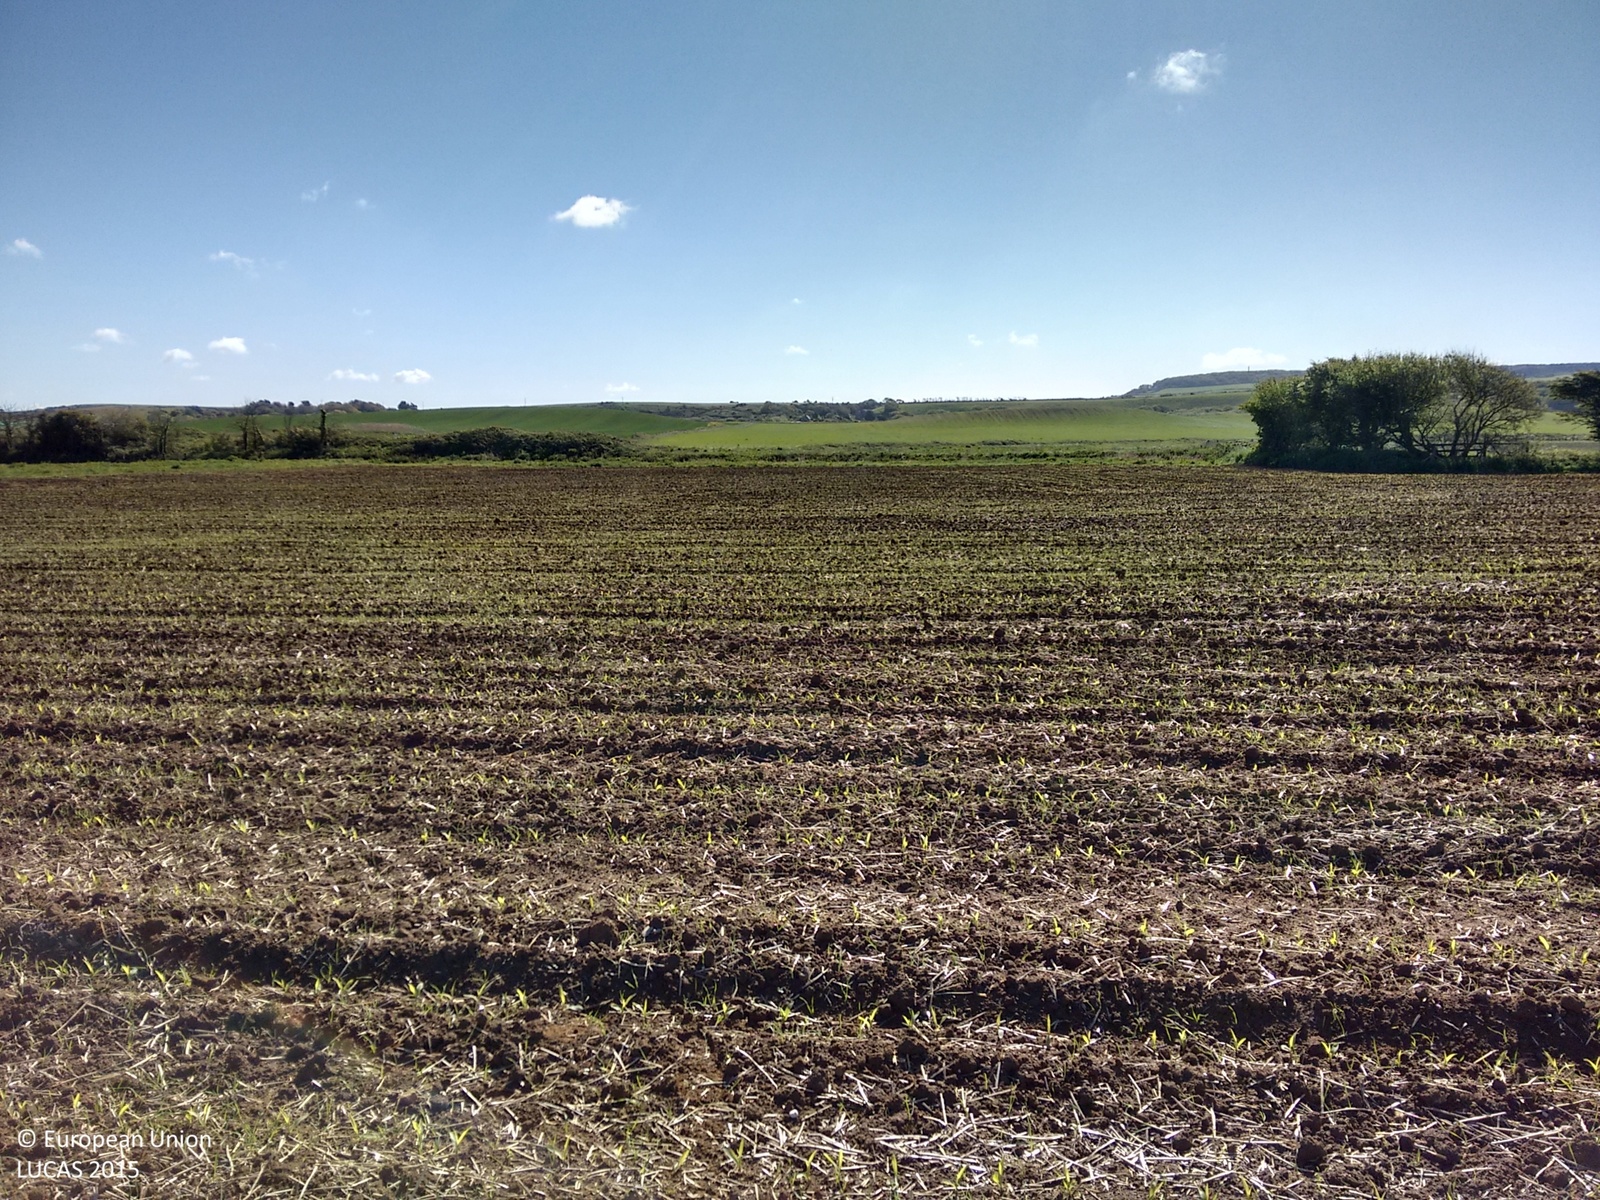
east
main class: Cropland
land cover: Maize
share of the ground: < 10 %
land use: Agriculture (excluding fallow land and kitchen gardens)
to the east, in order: Maize; Spontaneously vegetated surfaces; Ditches and canals; Shruby margins; Grassland without tree/shrub cover; Ditches and canals; Grassland without tree/shrub cover
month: May
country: GB
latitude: 50.6152
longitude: -1.3407
